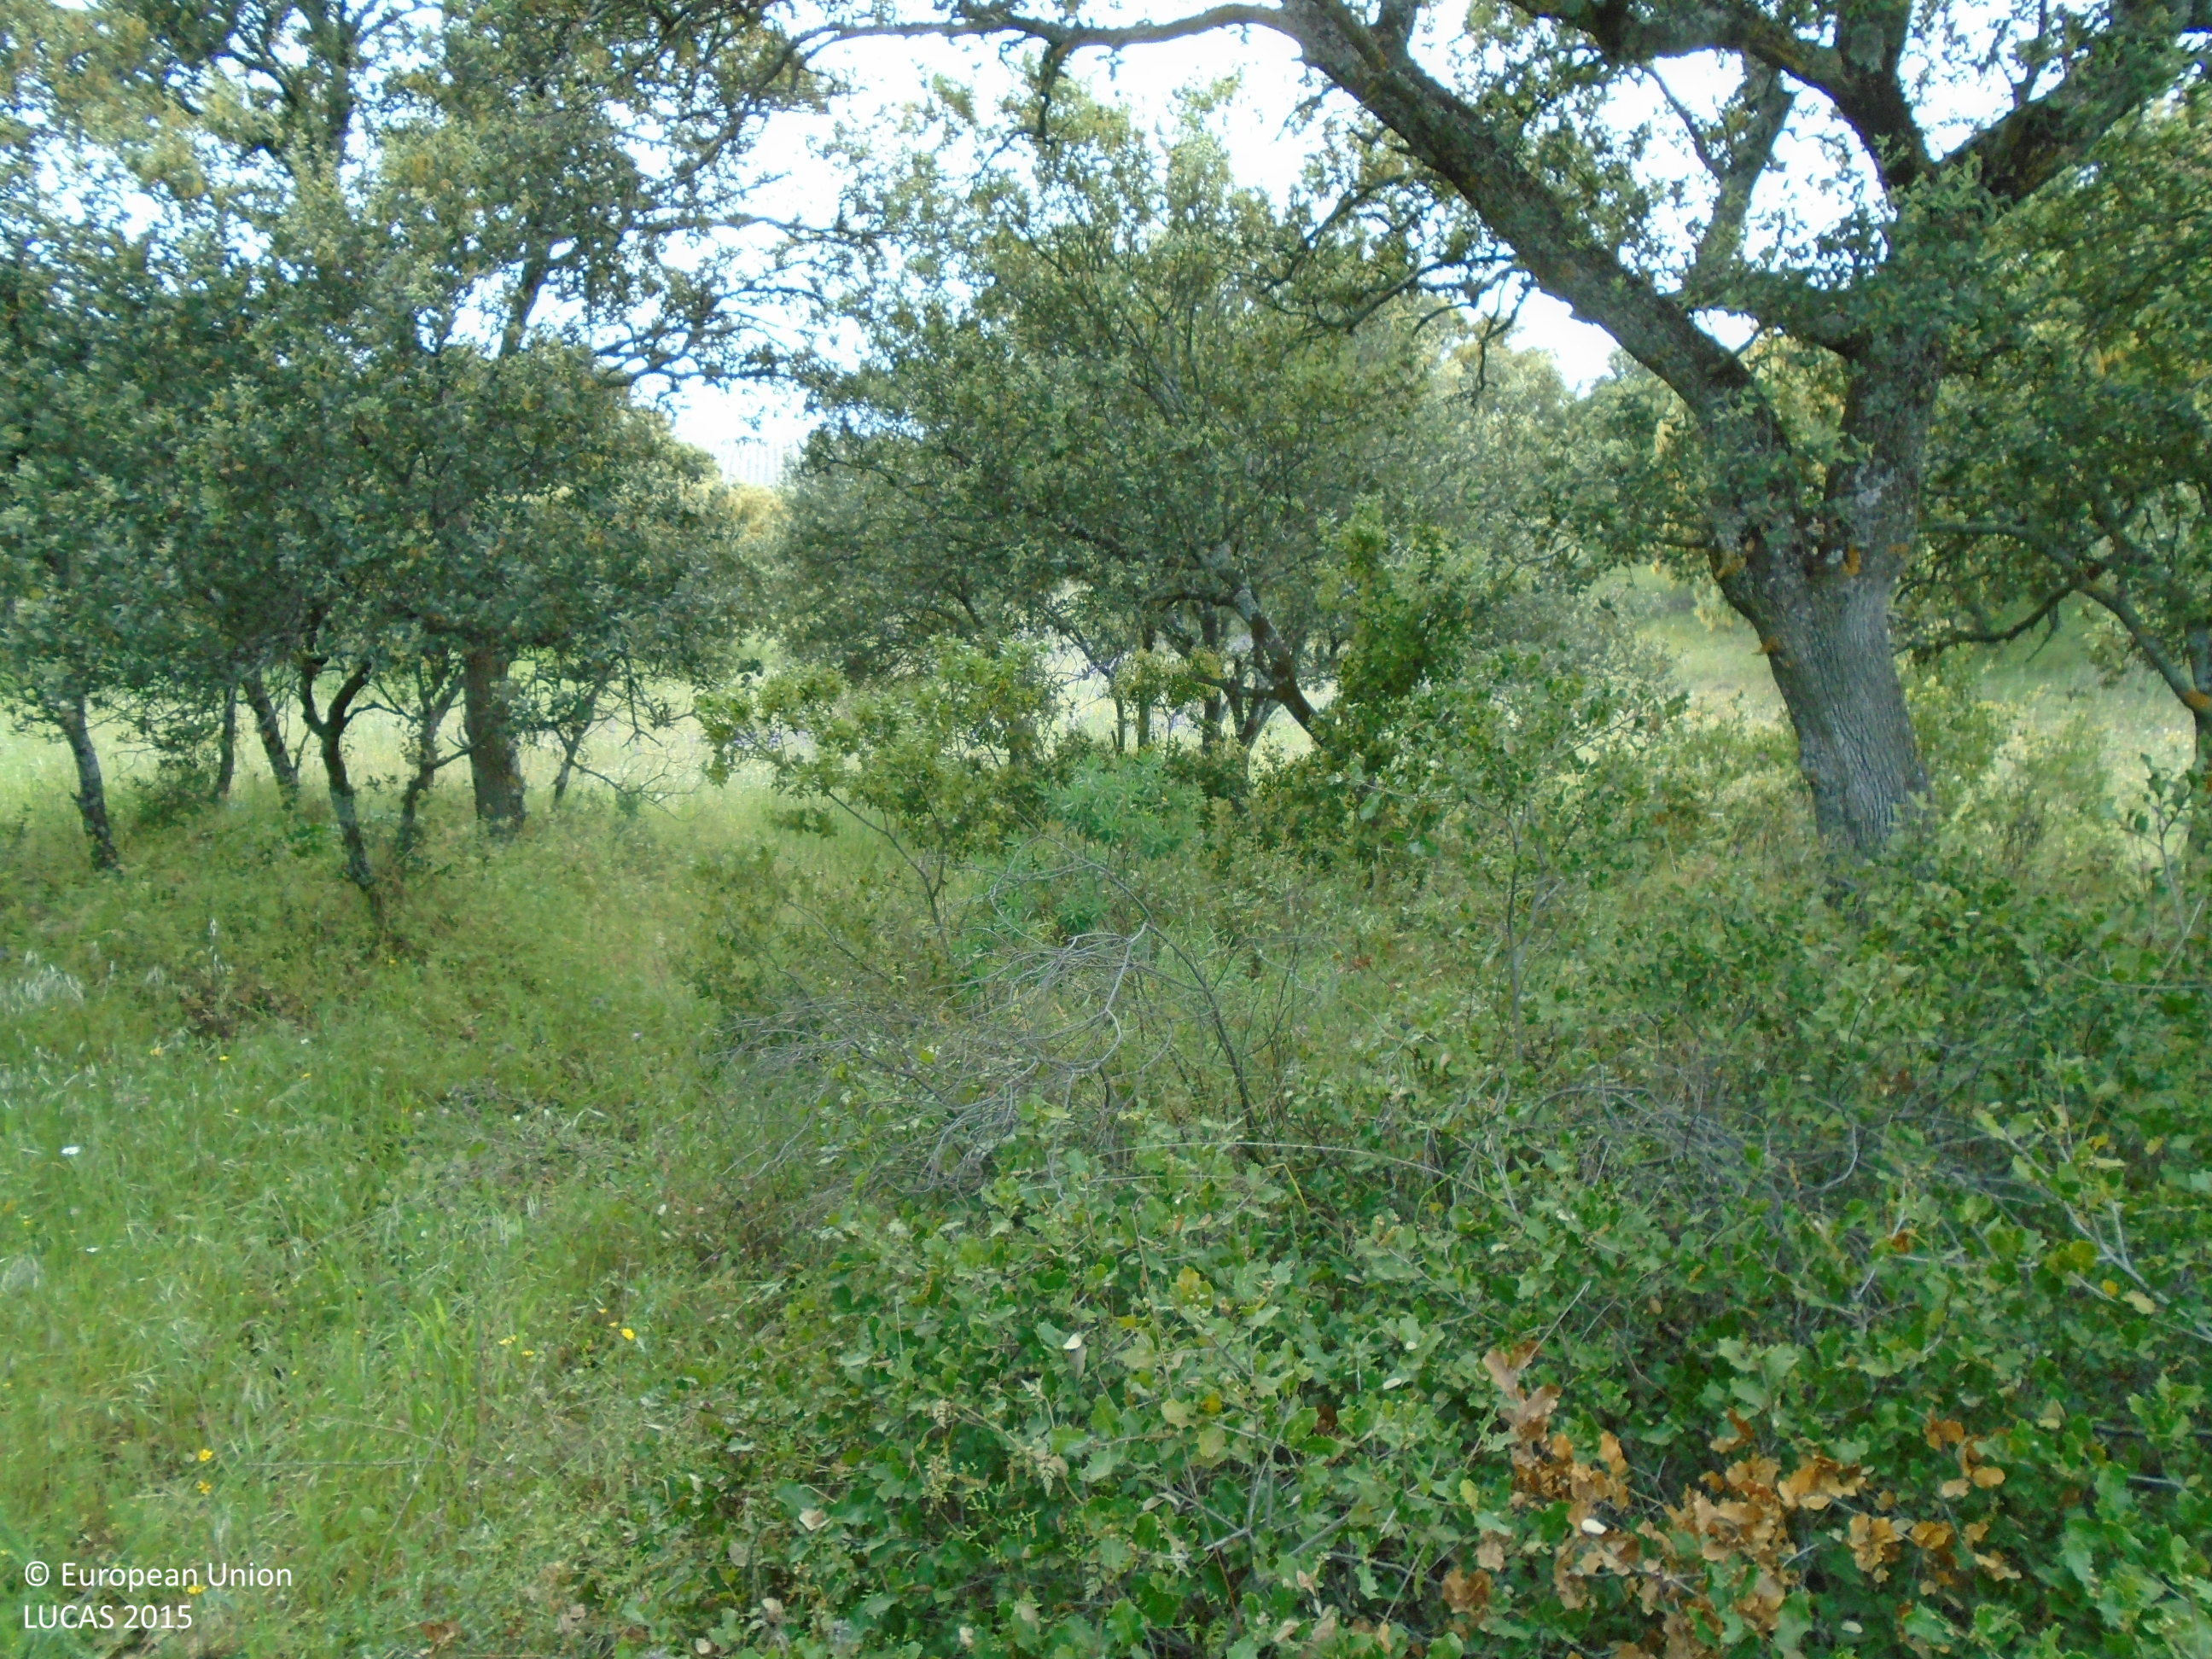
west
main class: Woodland
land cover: Broadleaved woodland
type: broadleaved evergreen forest
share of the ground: > 75 %
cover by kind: broadleaved forest trees 90 %, shrubs 5 %, herbaceous plants 5 %
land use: Semi-natural and natural areas not in use
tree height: > 5 m
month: May
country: ES
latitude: 39.7568
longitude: -4.7146
